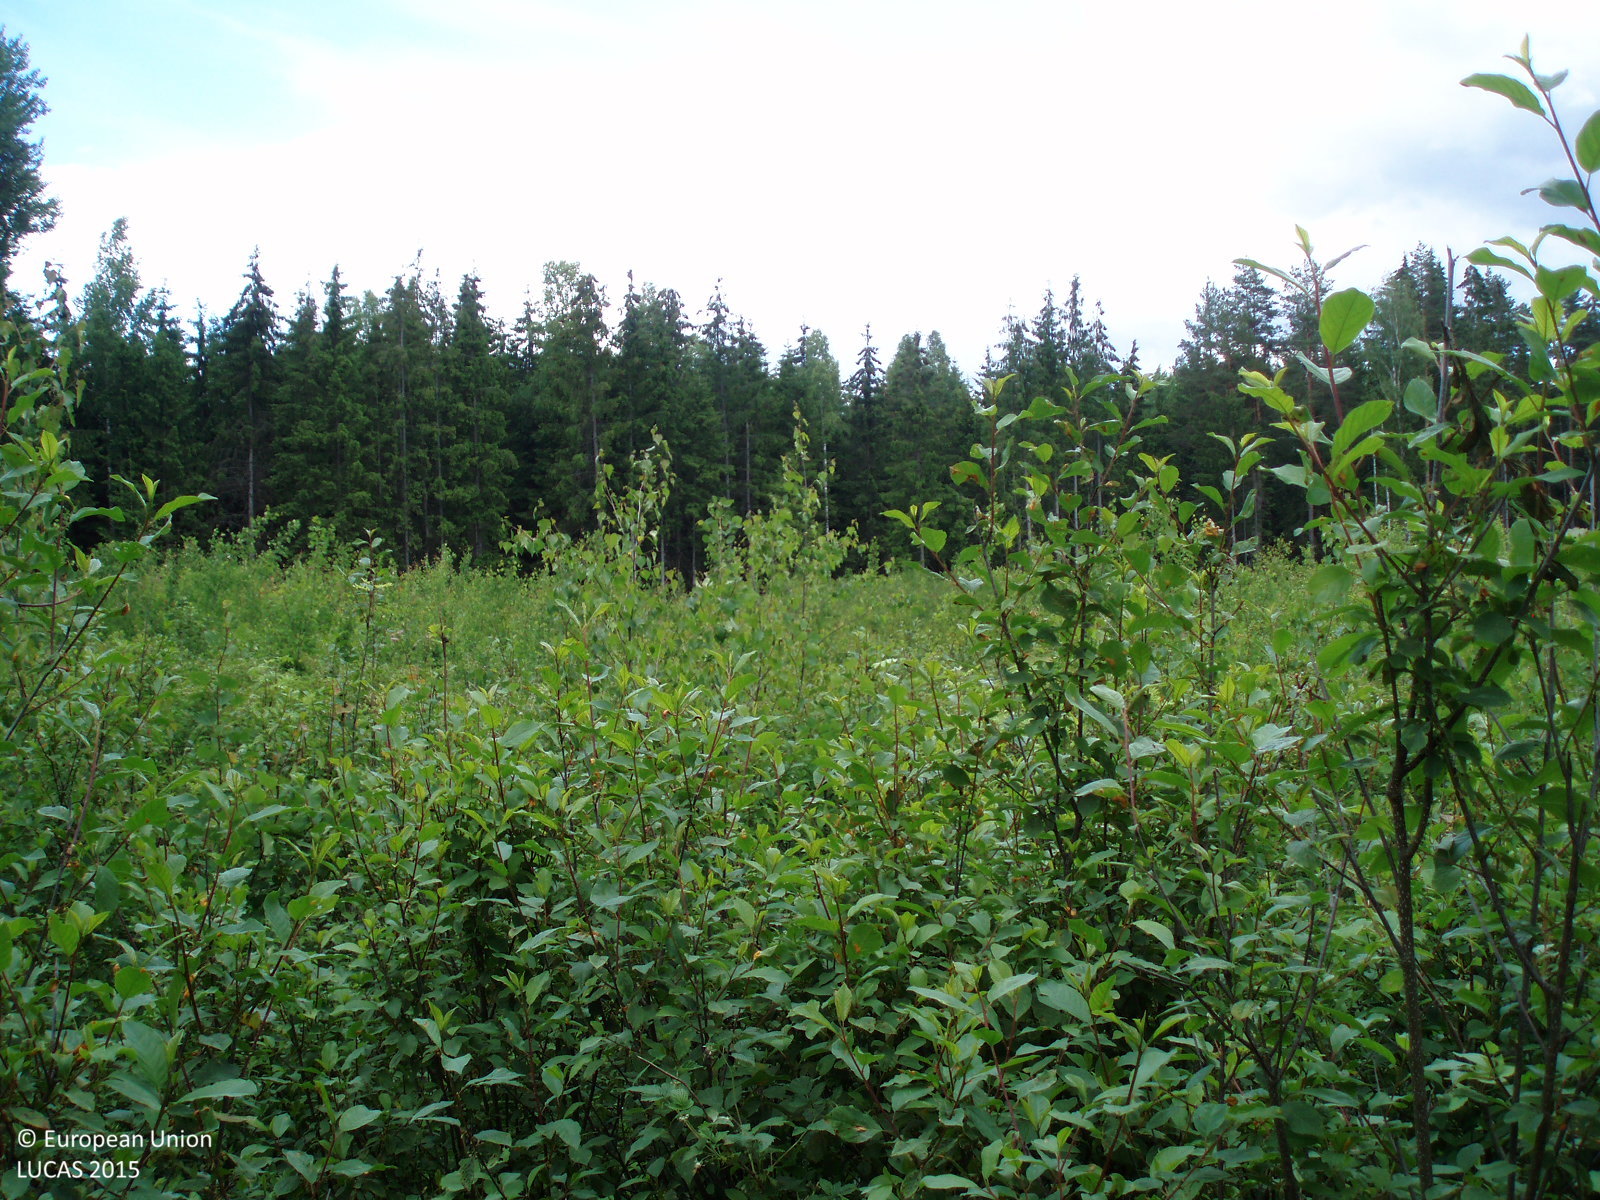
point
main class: Woodland
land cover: Broadleaved woodland
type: non-riverine alder, birch or aspen forest
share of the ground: 25 - 50 %
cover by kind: shrubs 50 %, broadleaved forest trees 30 %, herbaceous plants 20 %
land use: Forestry
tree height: < 5 m
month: June
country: LT
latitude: 55.0801
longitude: 22.5157
